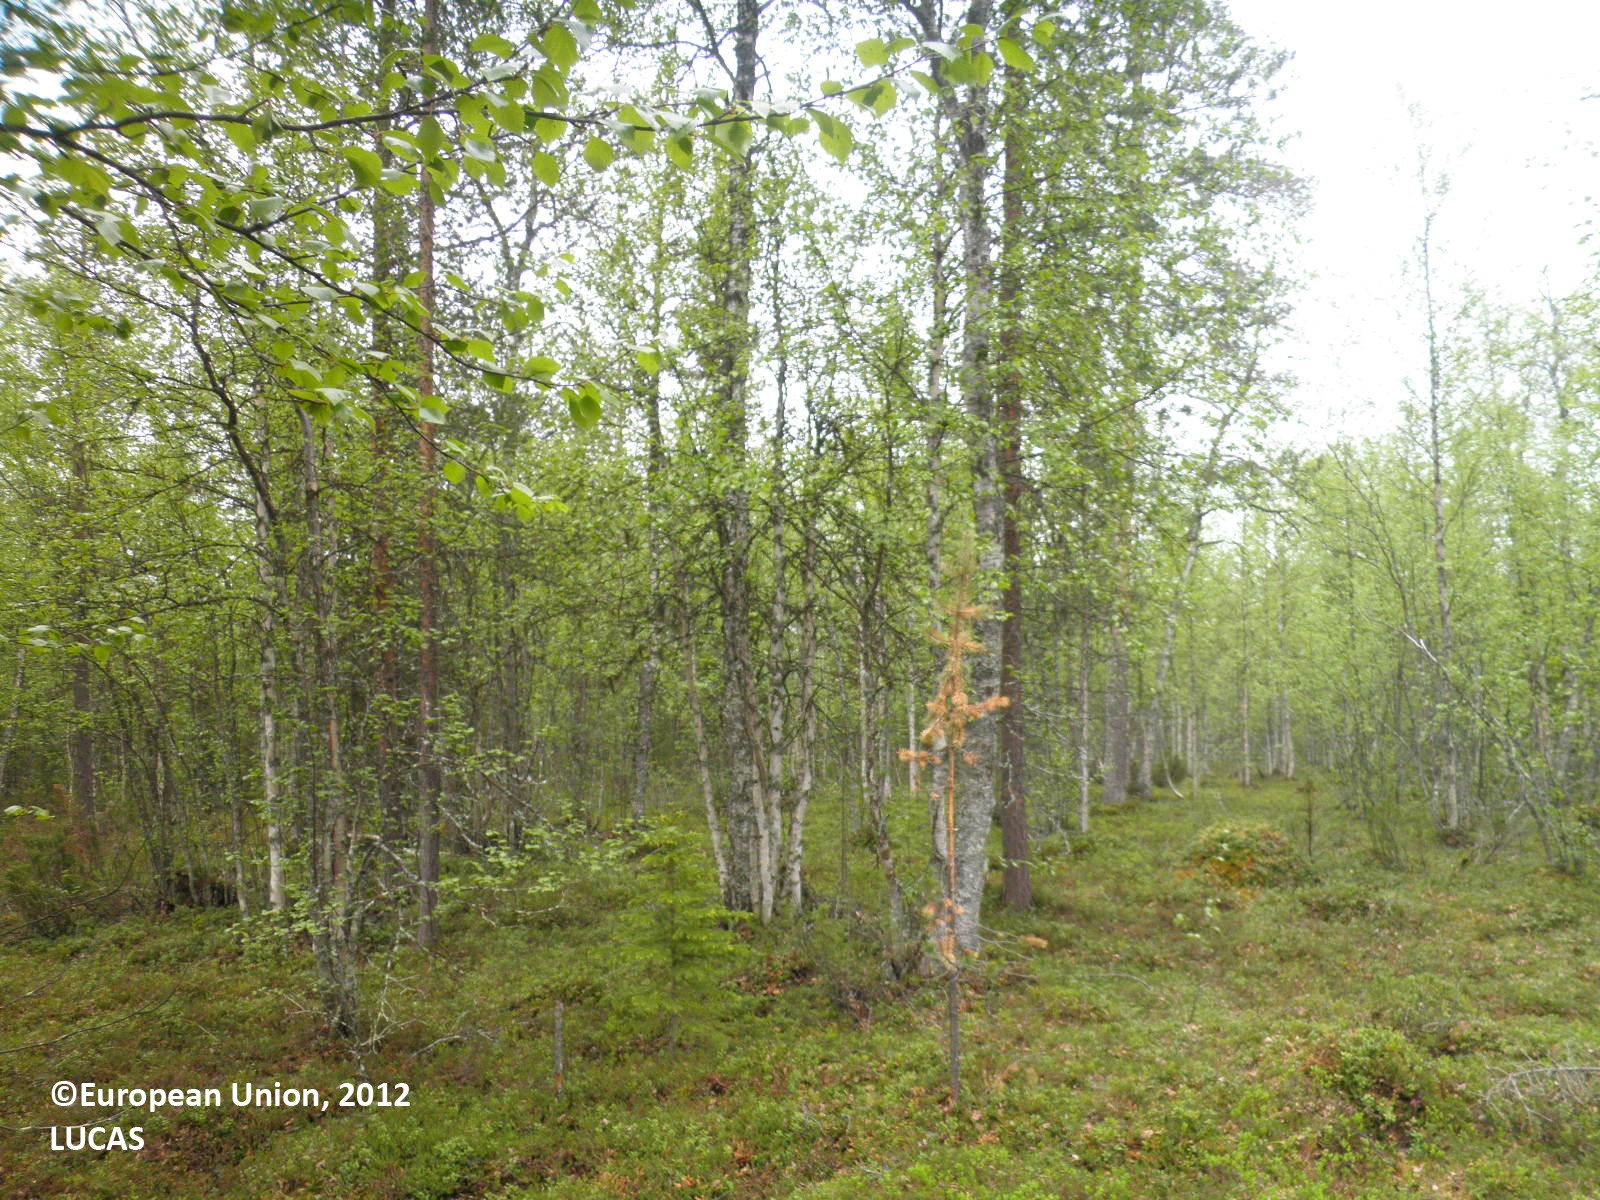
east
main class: Woodland
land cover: Pine dominated mixed woodland
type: boreal forest
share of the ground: 25 - 50 %
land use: Forestry
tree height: > 5 m
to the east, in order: Pine dominated mixed woodland; Spruce dominated mixed woodland; Pine dominated mixed woodland; Spruce dominated mixed woodland
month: June
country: FI
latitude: 67.9312
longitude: 25.4728
